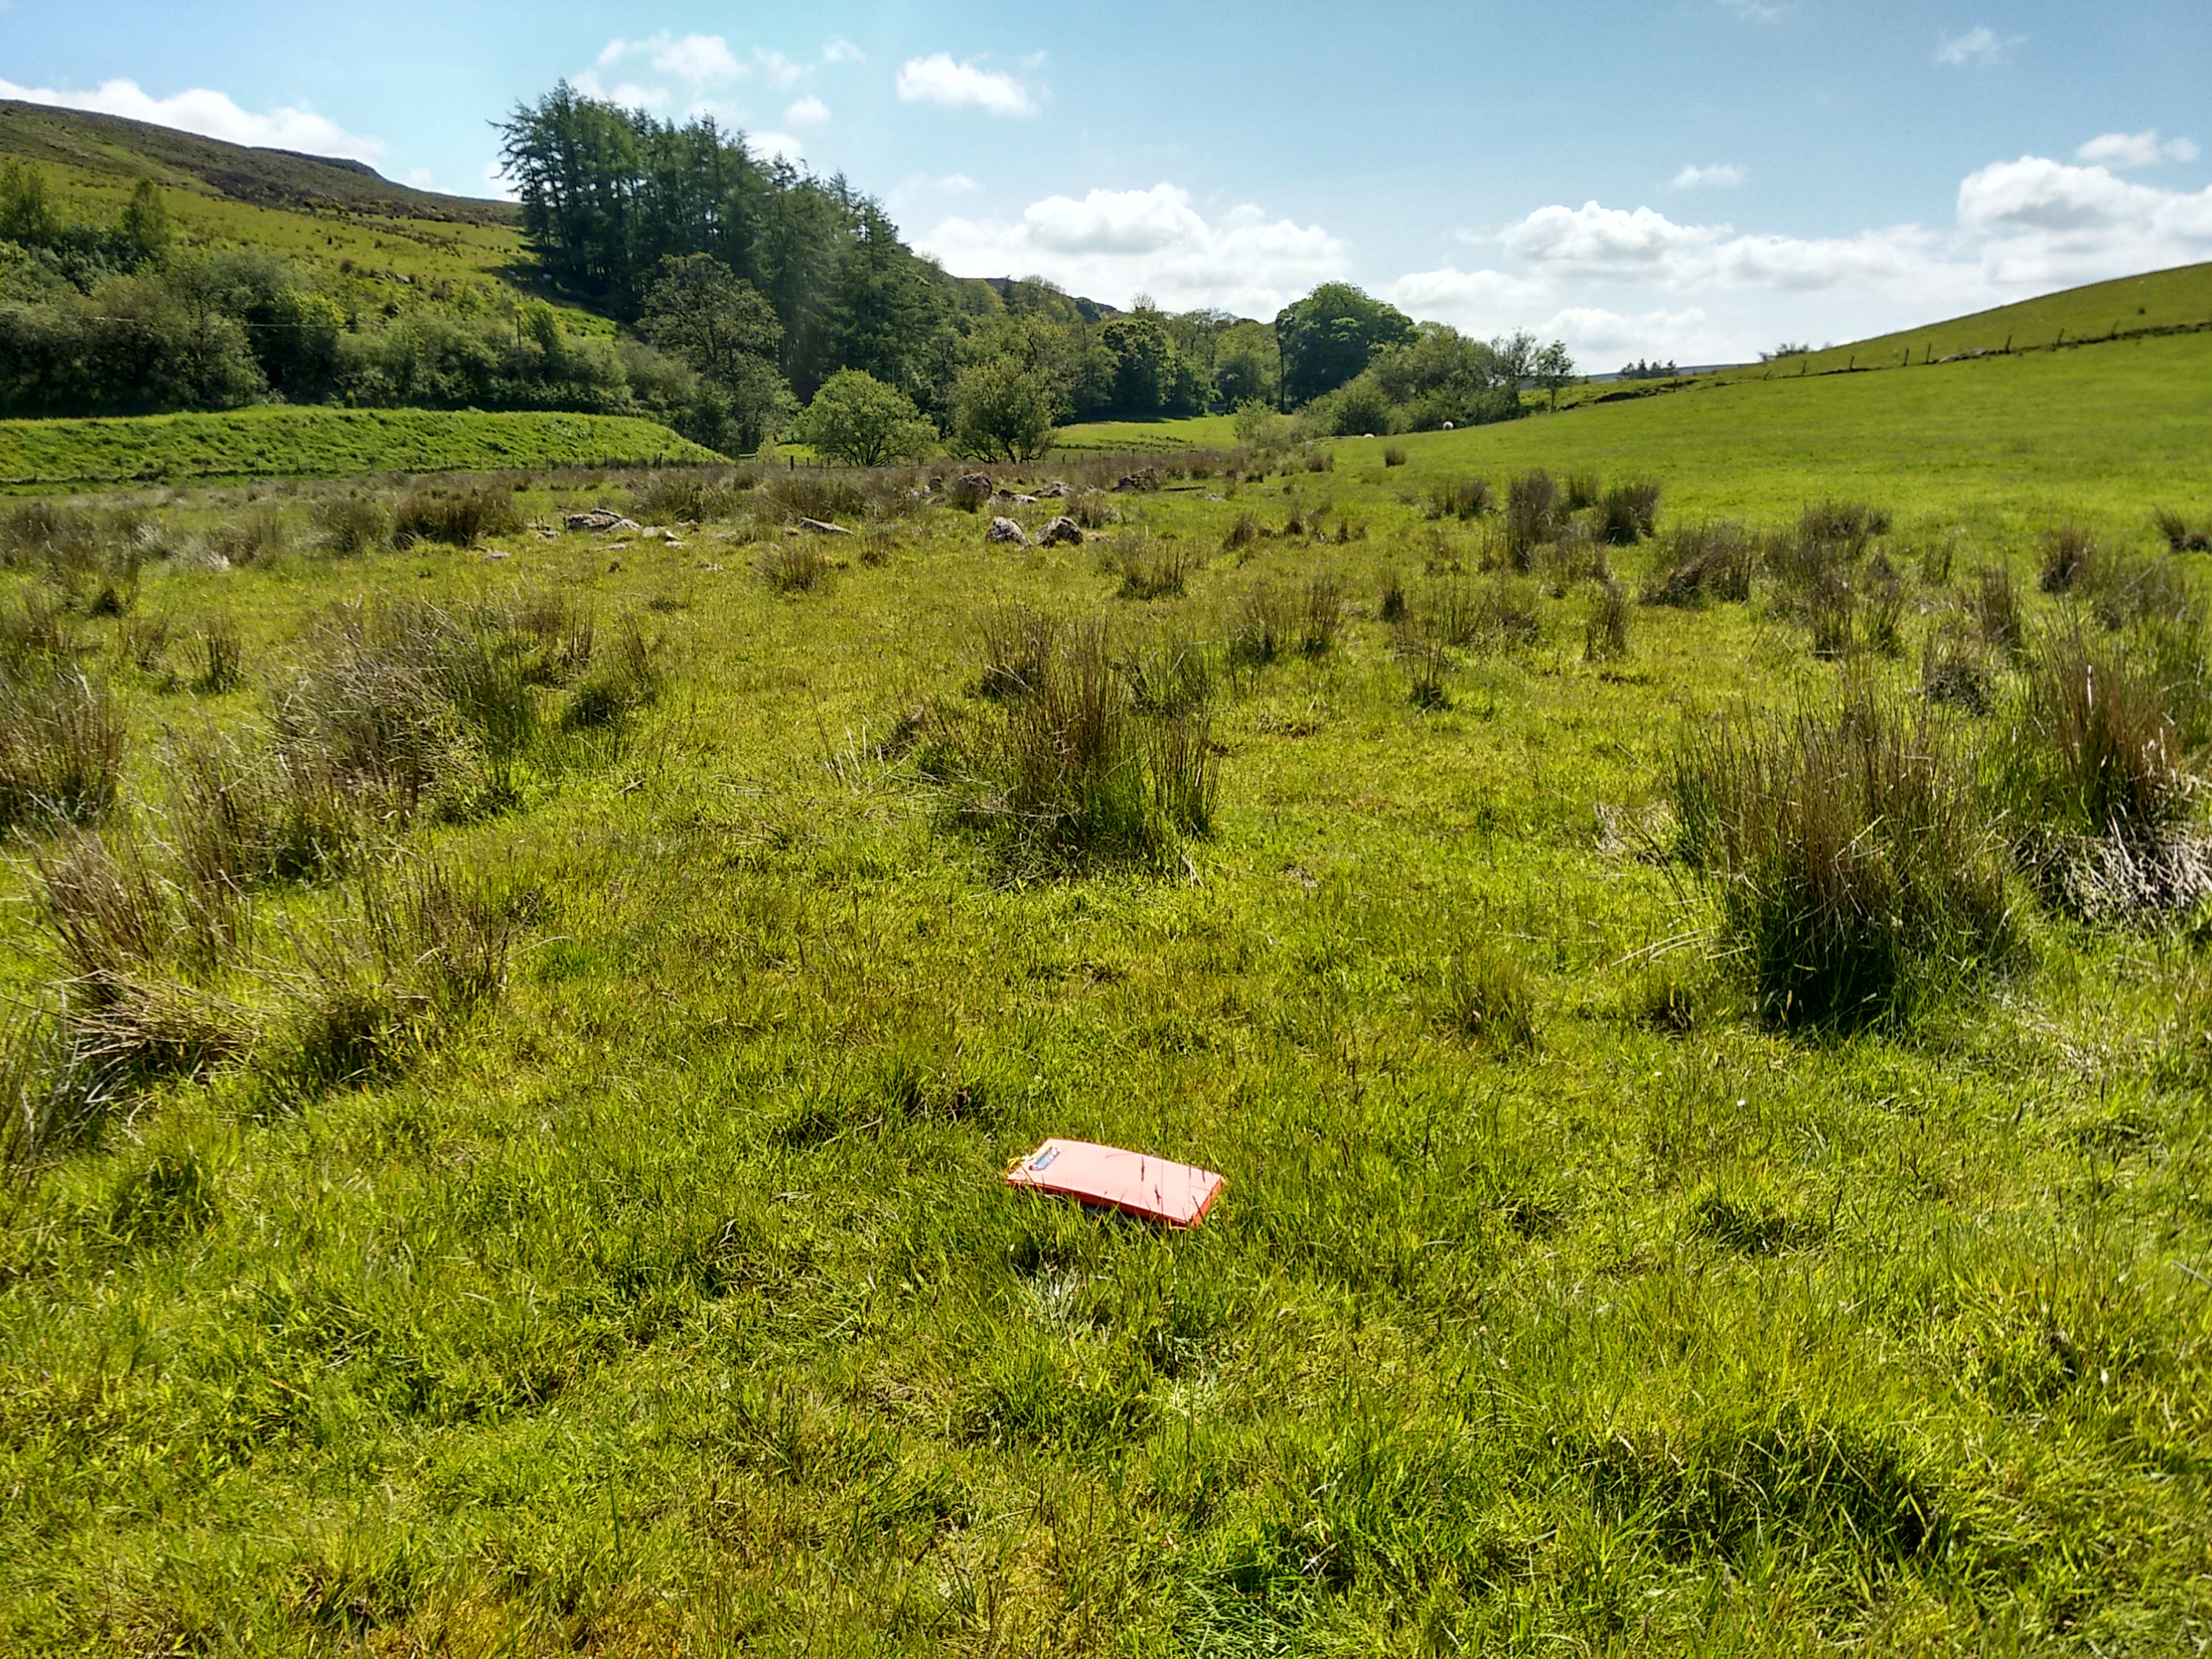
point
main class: Grassland
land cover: Grassland without tree/shrub cover
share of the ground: > 75 %
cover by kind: herbaceous plants 100 %
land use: Agriculture (excluding fallow land and kitchen gardens)
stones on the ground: < 10 %
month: June
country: GB
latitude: 54.8038
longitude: -7.2436
